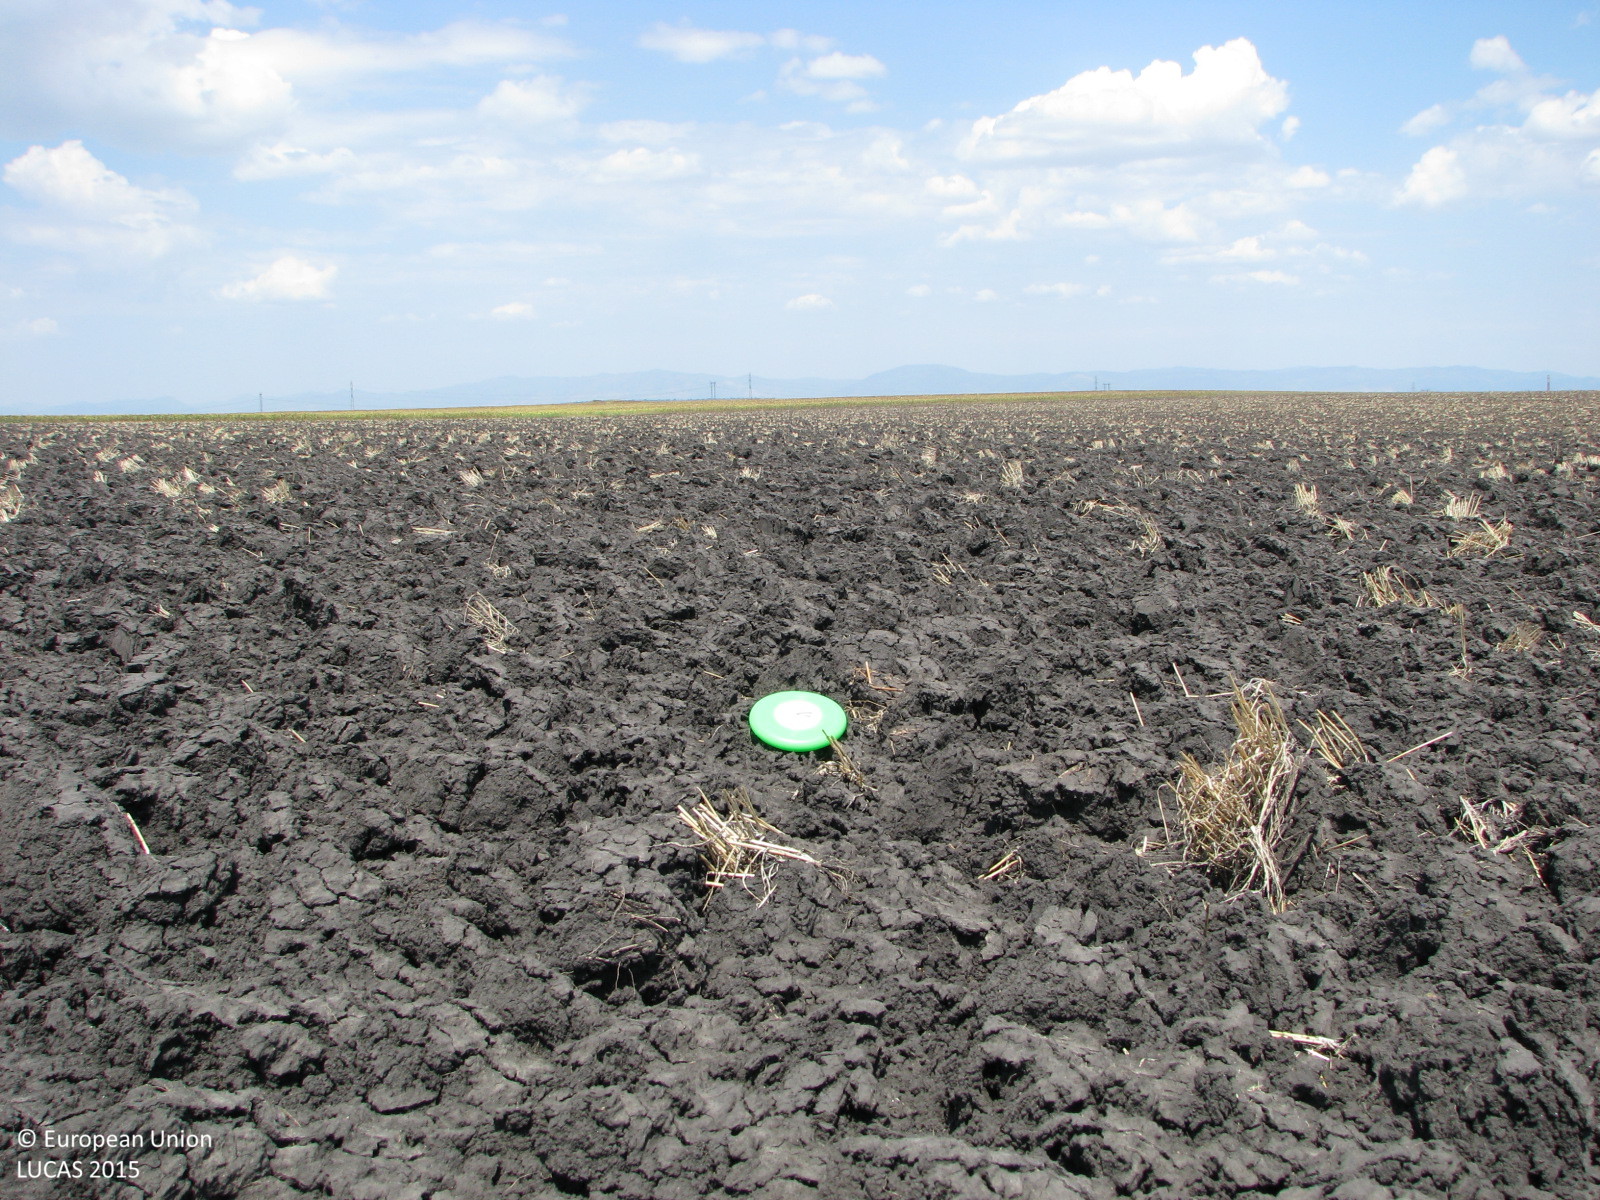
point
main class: Cropland
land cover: Common wheat
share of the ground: < 10 %
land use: Agriculture (excluding fallow land and kitchen gardens)
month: August
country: BG
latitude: 42.4184
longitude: 26.4600
